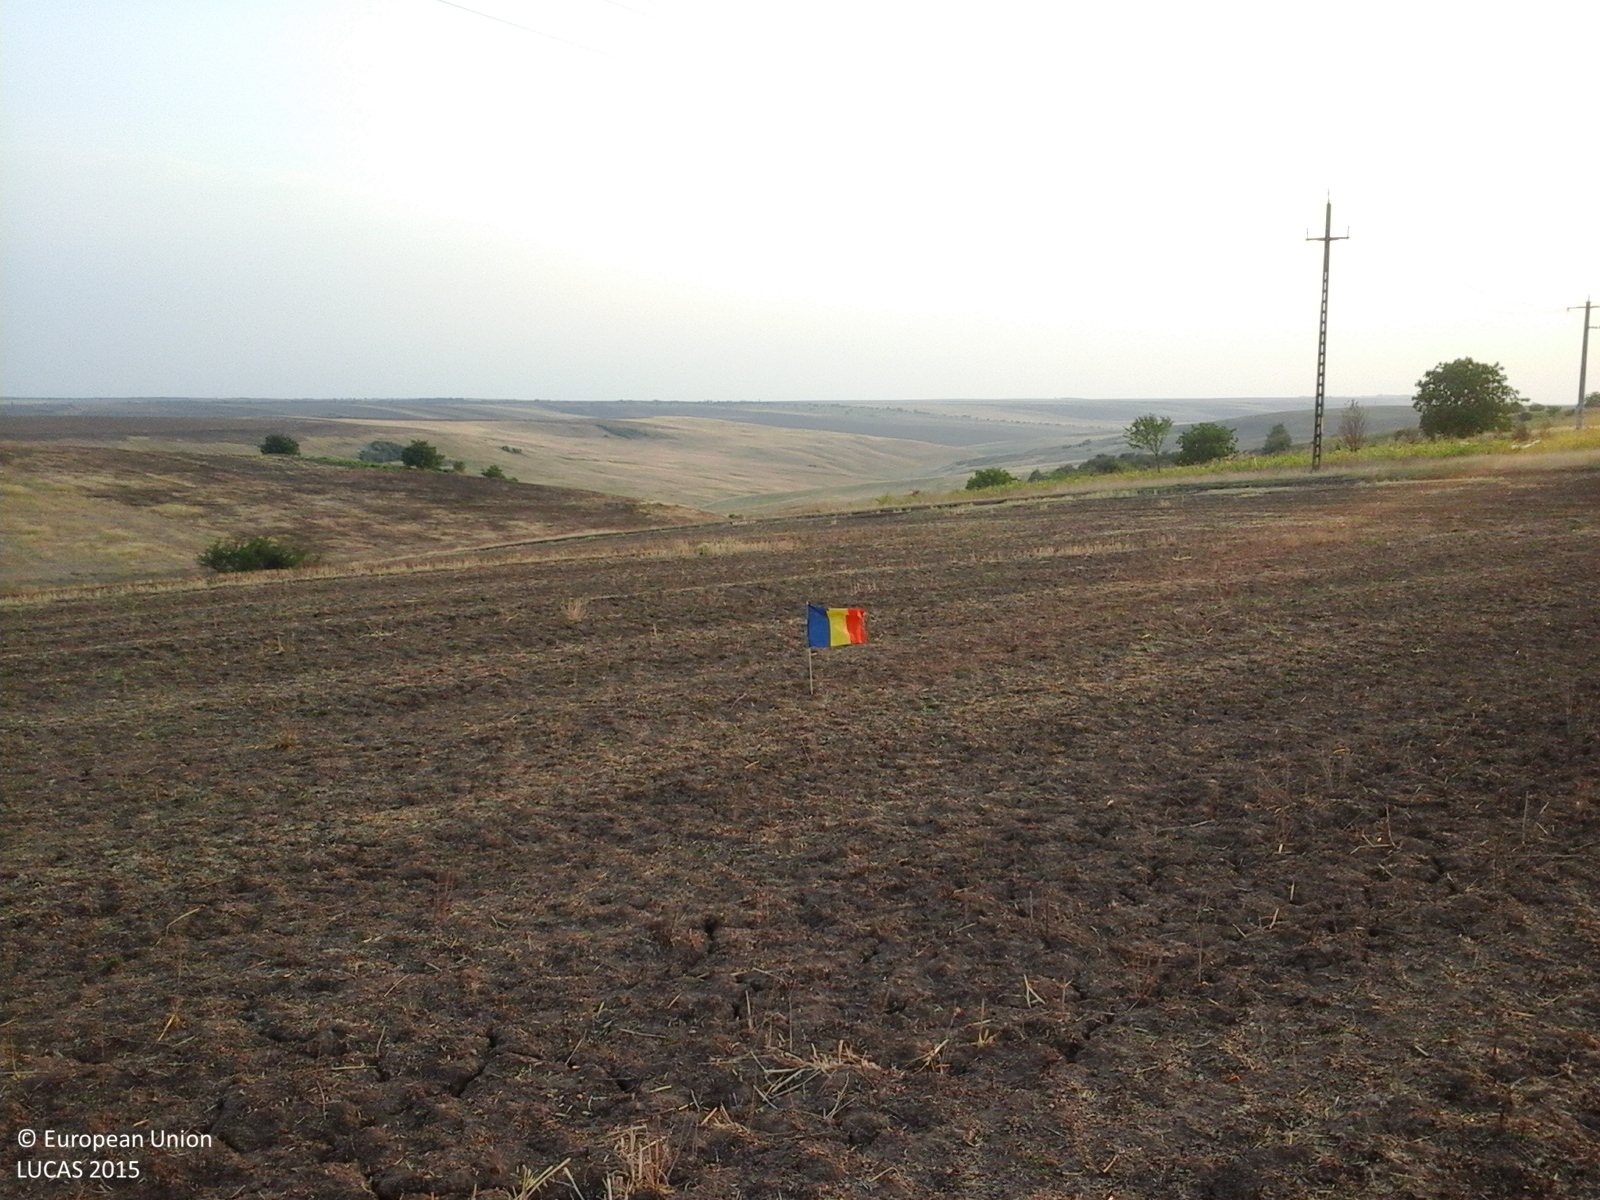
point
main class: Cropland
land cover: Common wheat
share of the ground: < 10 %
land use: Agriculture (excluding fallow land and kitchen gardens)
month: August
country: RO
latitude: 44.4143
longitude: 23.0691
